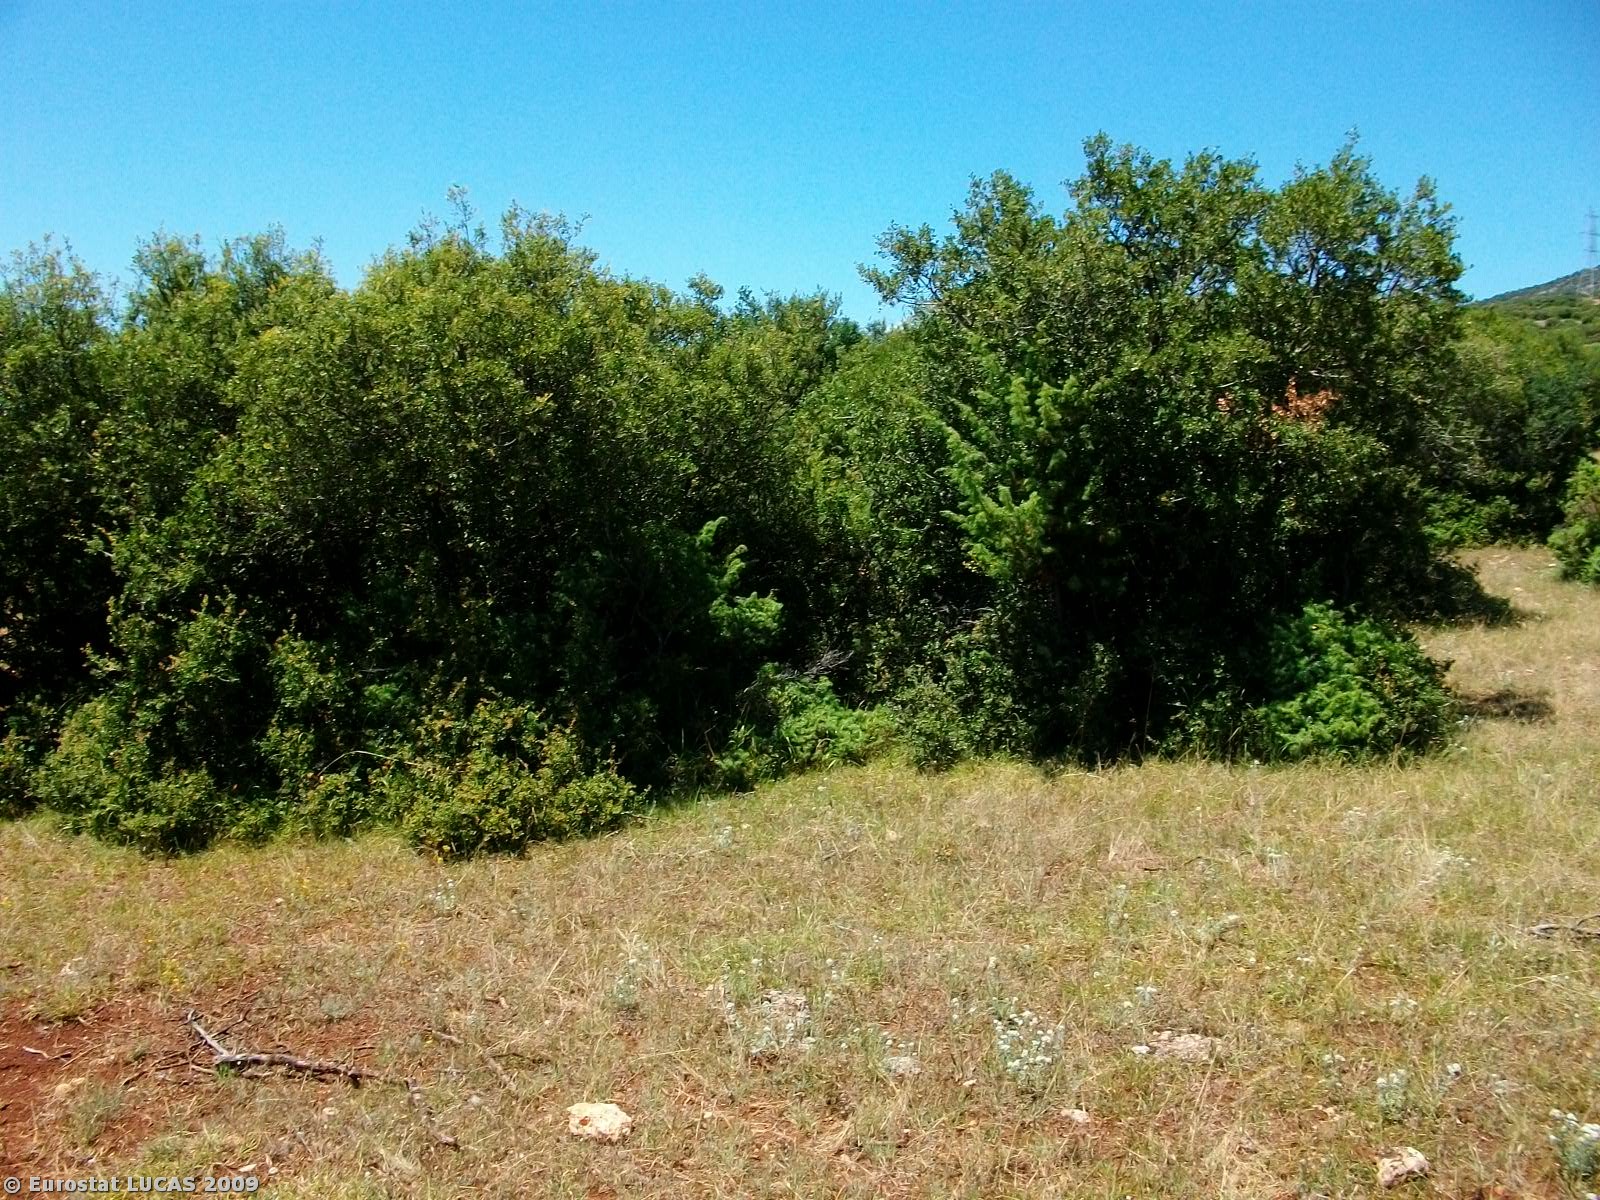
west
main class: Shrubland
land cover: Shrubland without tree cover
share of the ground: 50 - 75 %
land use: Unused
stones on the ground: 10 - 25 %
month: July
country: GR
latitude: 40.1209
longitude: 21.7825
